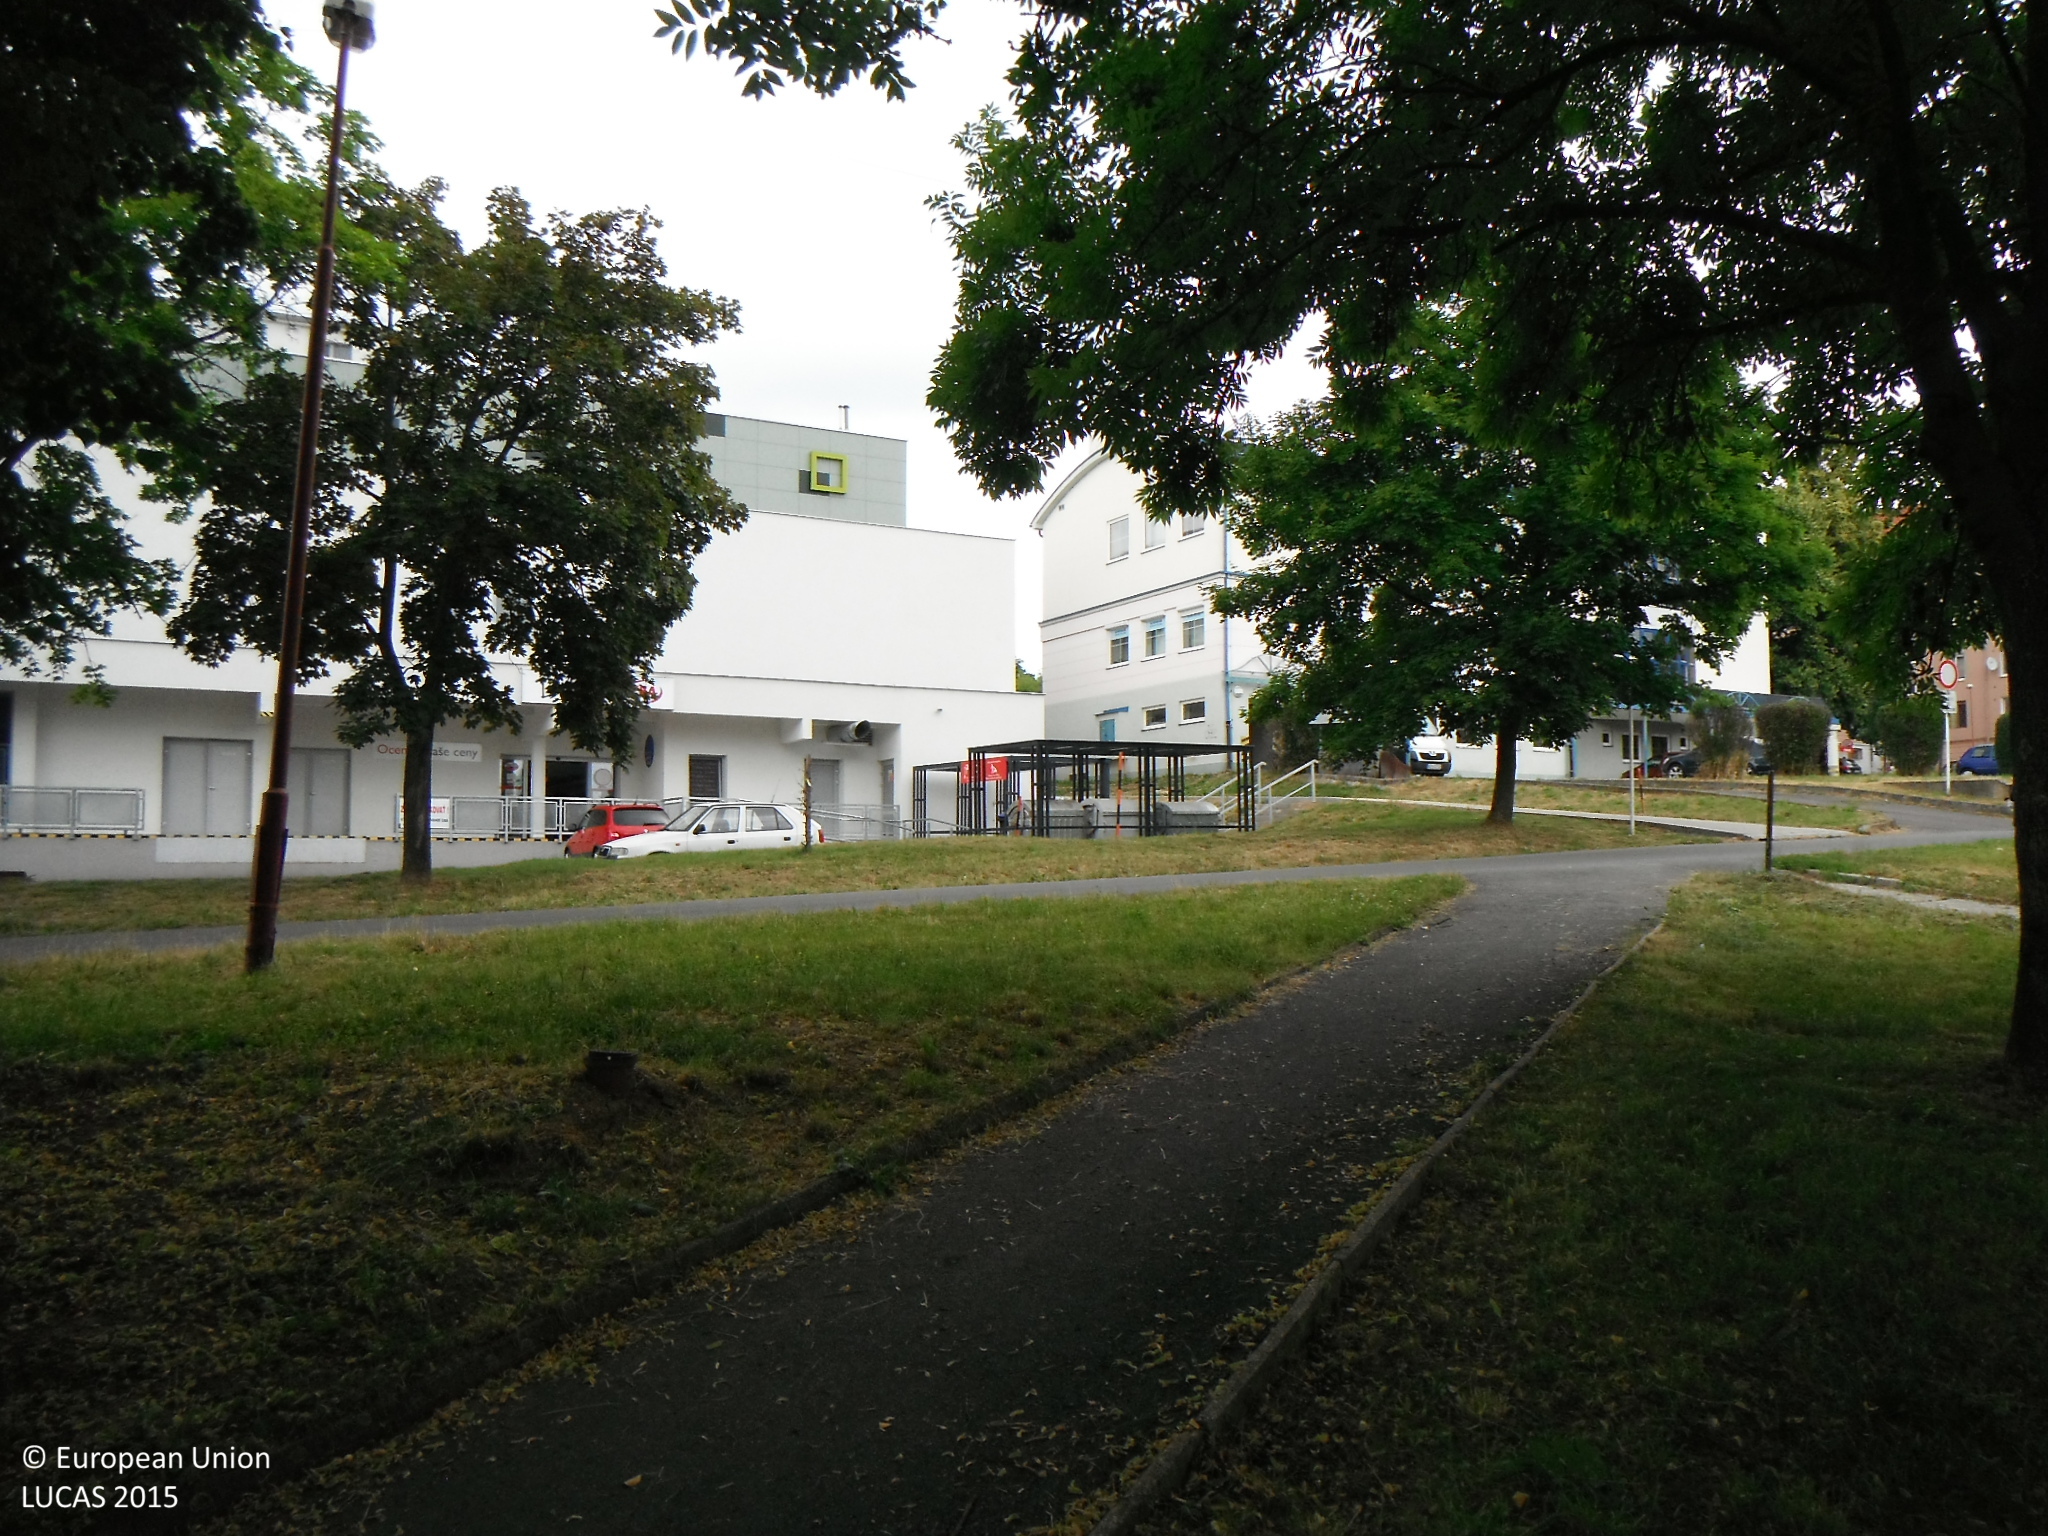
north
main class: Woodland
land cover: Broadleaved woodland
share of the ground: 50 - 75 %
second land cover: Grassland without tree/shrub cover
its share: > 75 %
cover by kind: broadleaved forest trees 70 %, herbaceous plants 30 %
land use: Residential
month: June
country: SK
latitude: 48.2060
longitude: 19.3478
